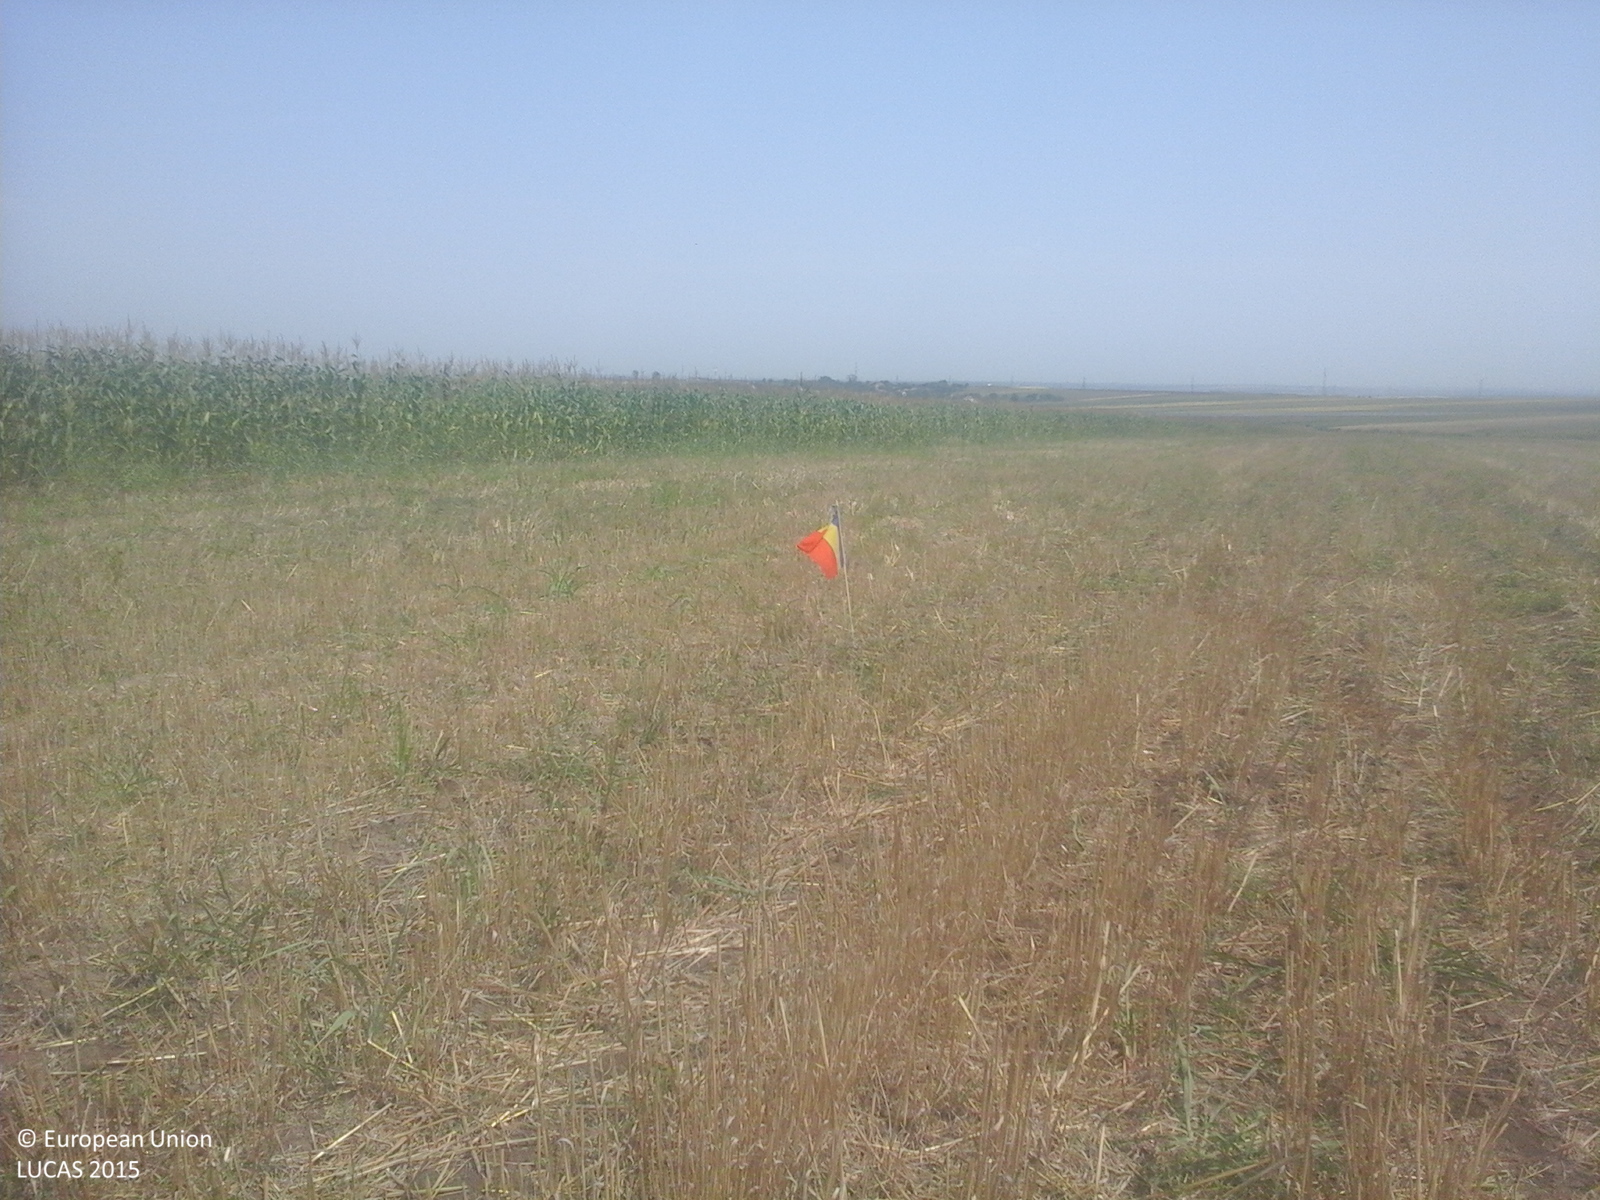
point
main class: Cropland
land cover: Barley
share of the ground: 50 - 75 %
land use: Agriculture (excluding fallow land and kitchen gardens)
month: August
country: RO
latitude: 44.1583
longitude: 28.3328
